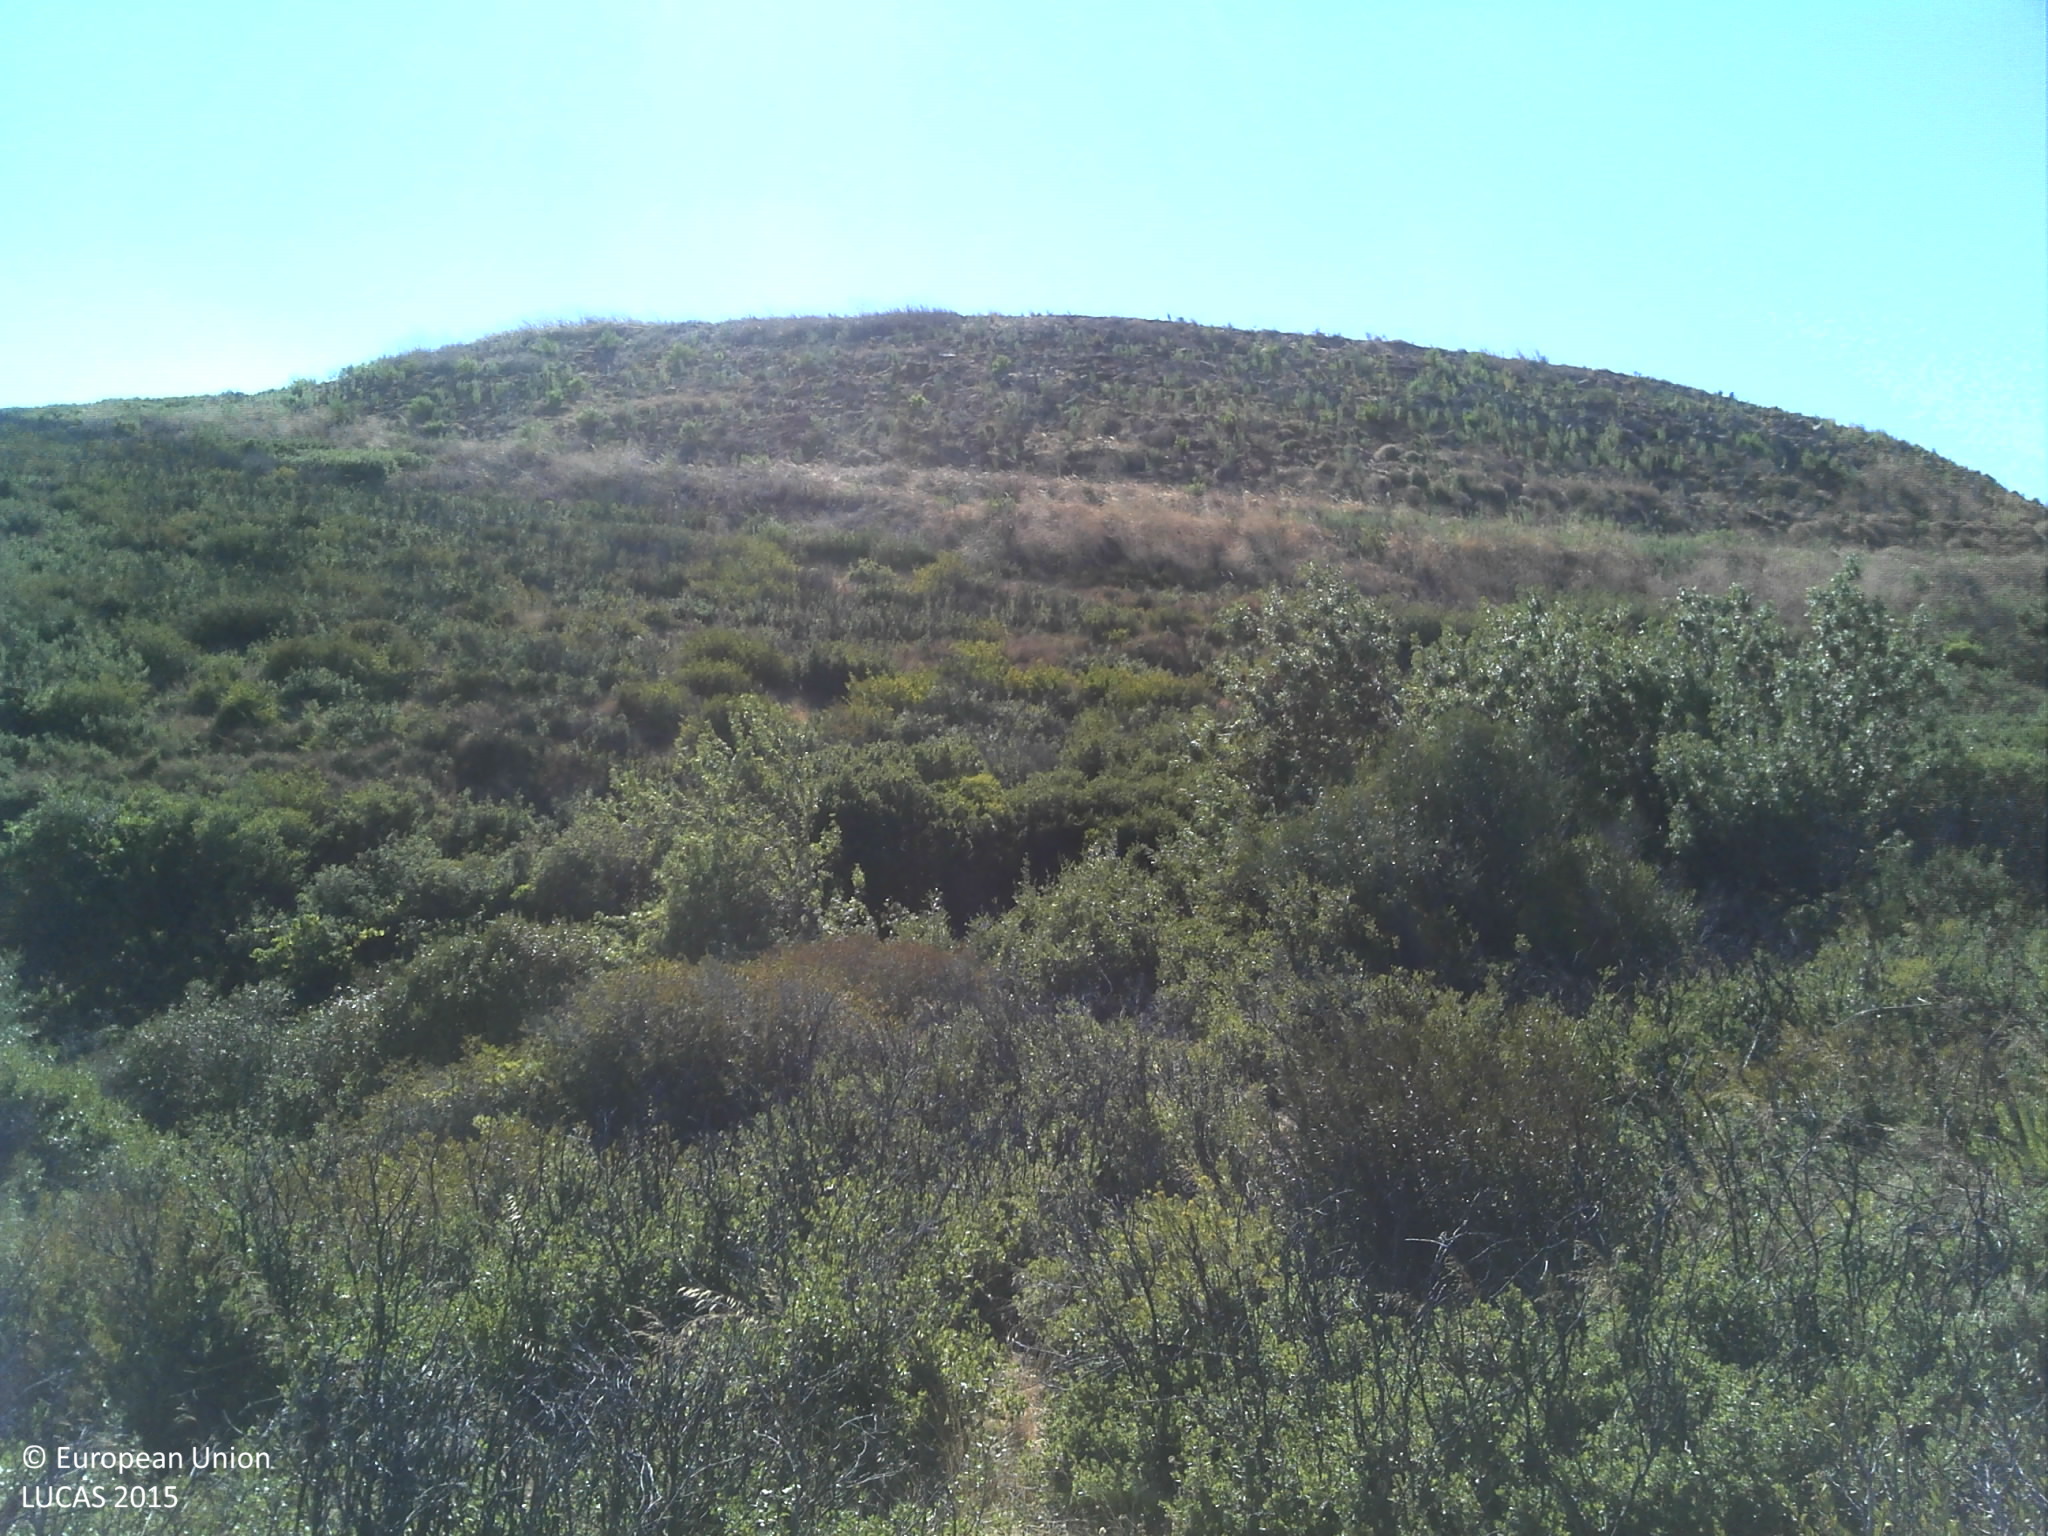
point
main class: Shrubland
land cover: Shrubland with sparse tree cover
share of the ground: 50 - 75 %
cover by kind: shrubs 65 %, unconsolidated bare surface 30 %, broadleaved forest trees 5 %
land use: Semi-natural and natural areas not in use
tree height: > 5 m
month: August
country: PT
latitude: 38.8566
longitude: -9.1733
